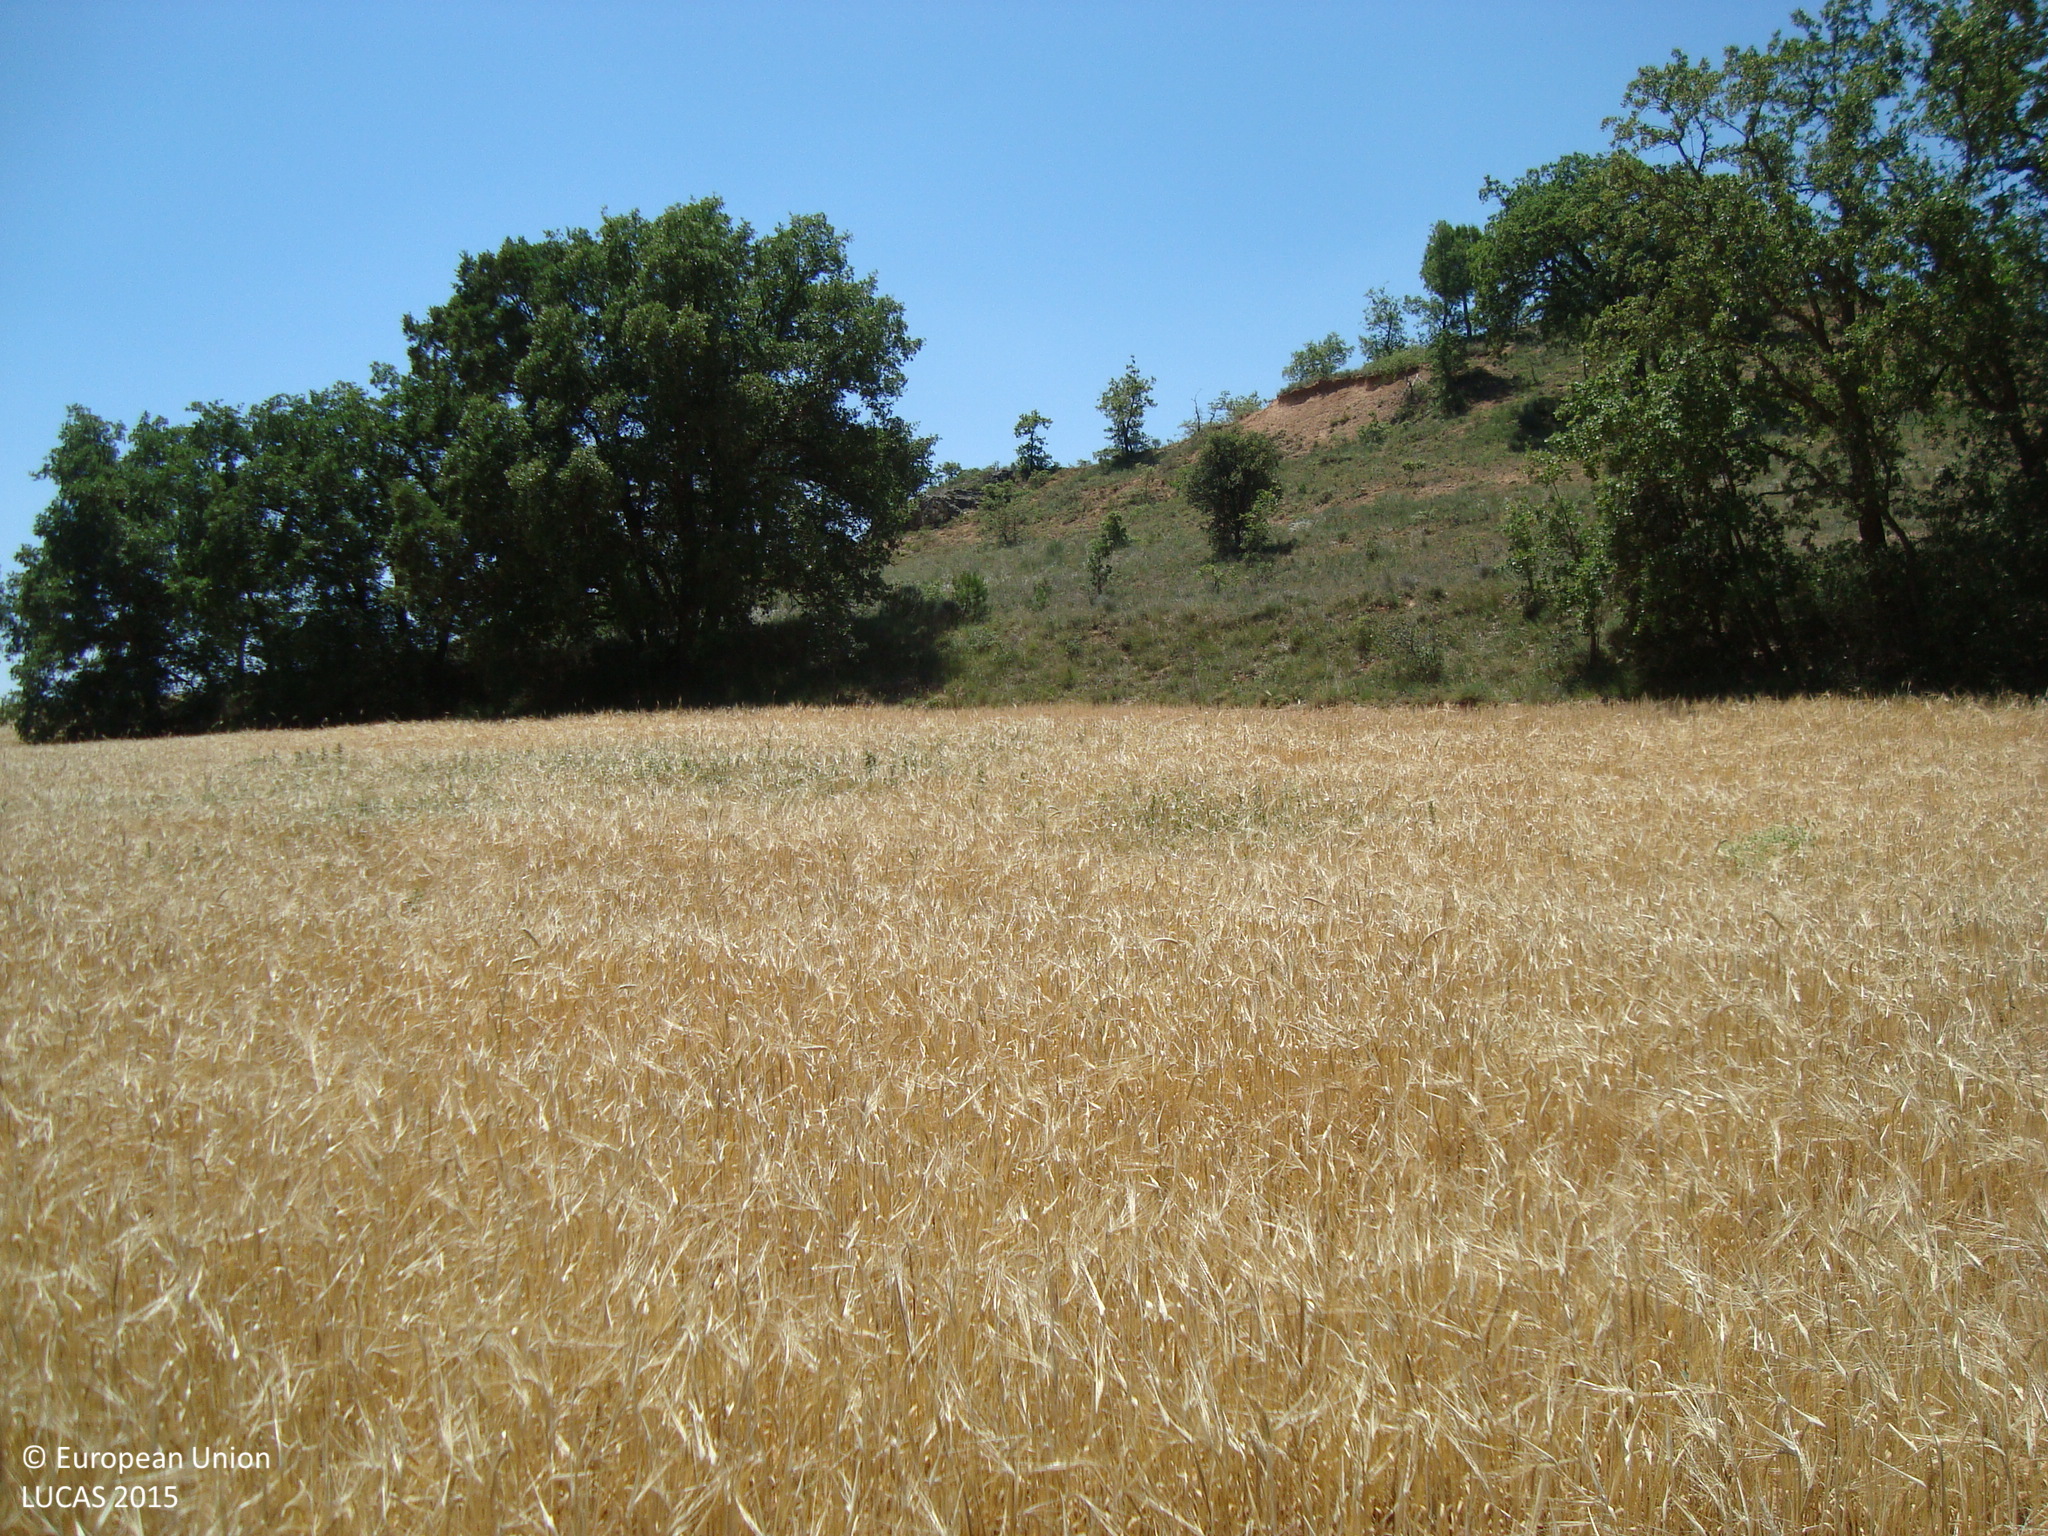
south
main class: Cropland
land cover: Barley
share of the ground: > 75 %
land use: Agriculture (excluding fallow land and kitchen gardens)
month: June
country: ES
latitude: 41.7266
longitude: -3.7711
